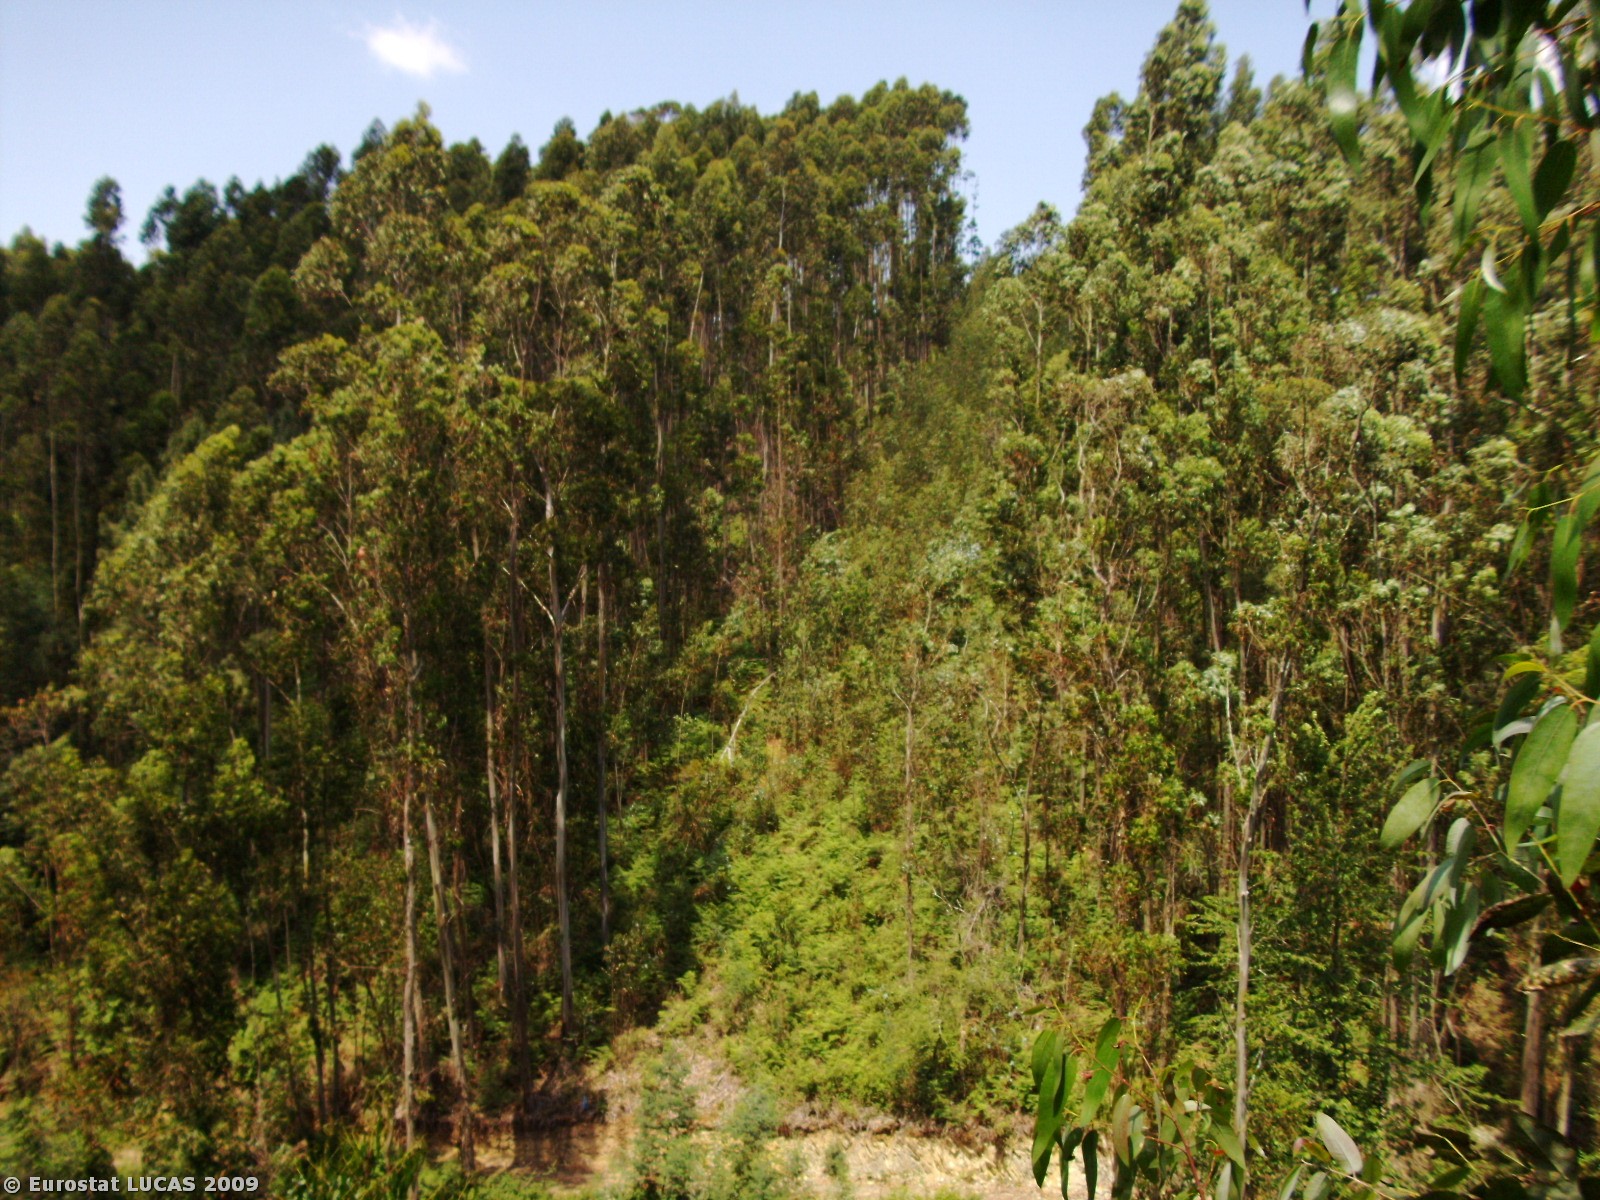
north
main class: Shrubland
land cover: Shrubland with sparse tree cover
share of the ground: > 75 %
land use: Forestry
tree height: > 5 m
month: May
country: PT
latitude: 40.2946
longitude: -8.3524
